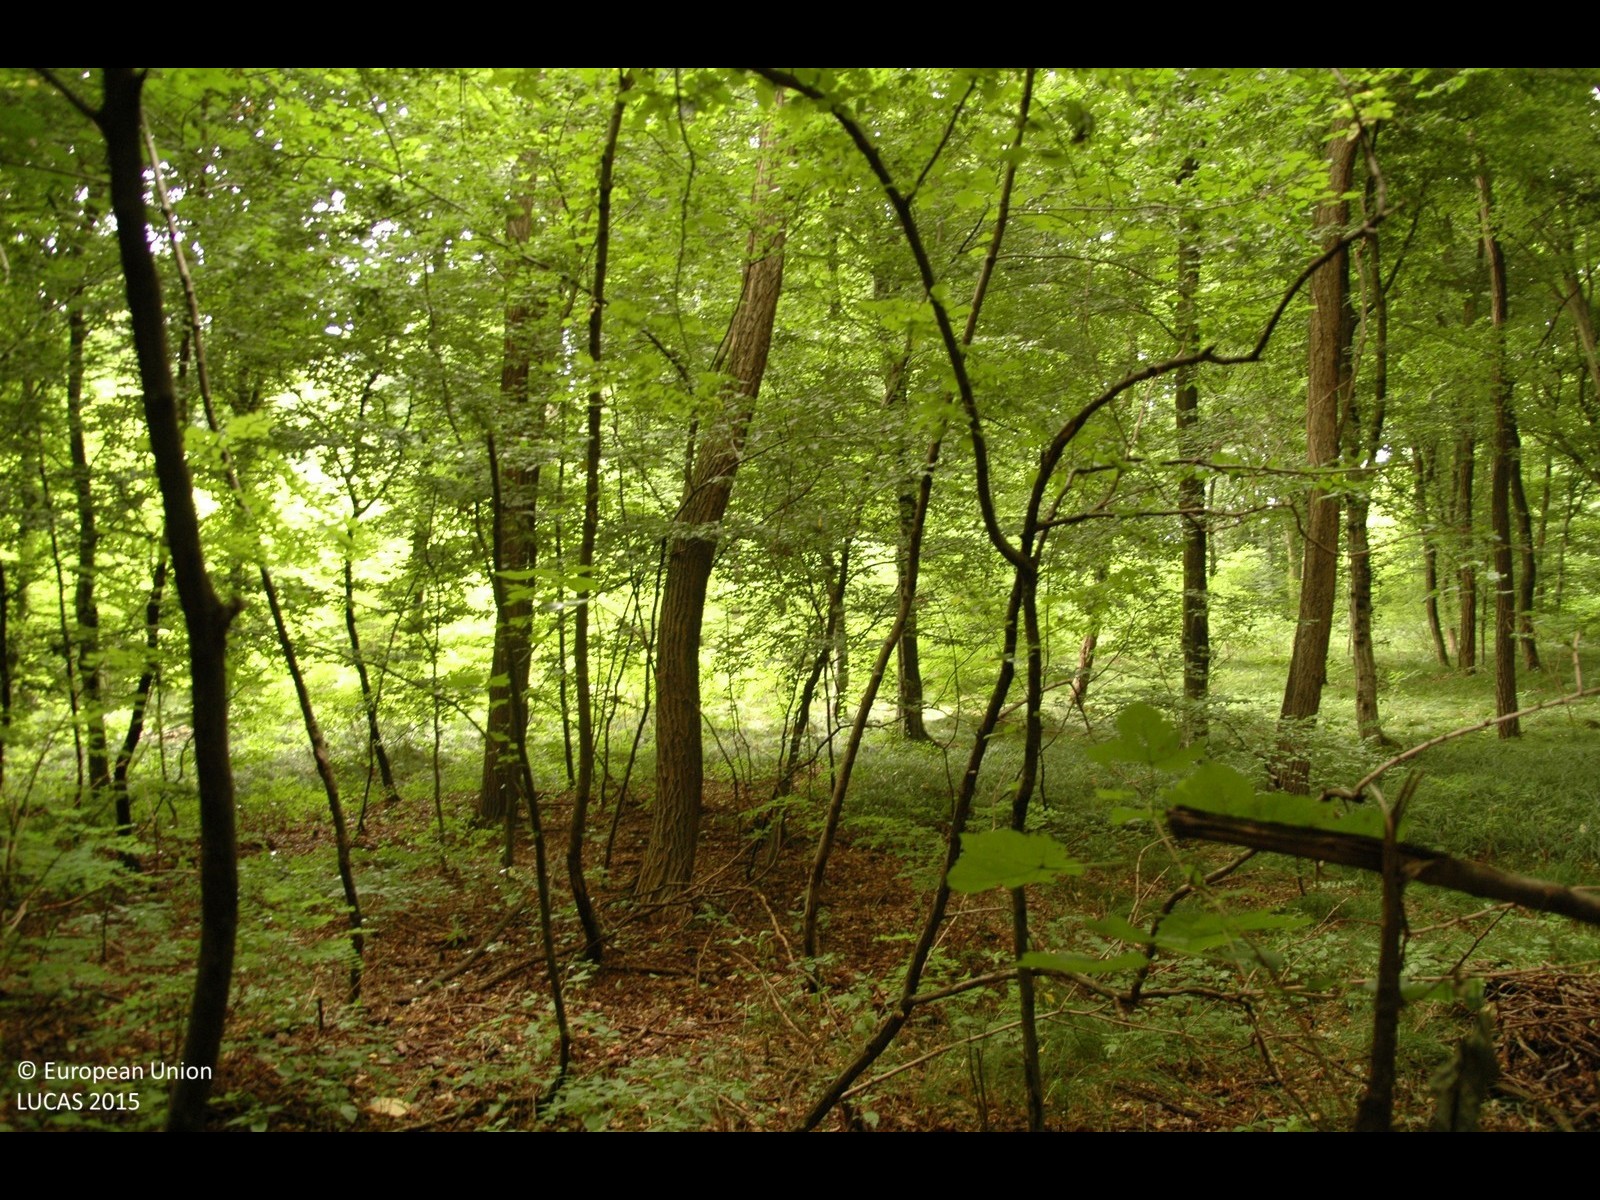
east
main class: Woodland
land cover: Broadleaved woodland
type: mesophytic deciduous forest
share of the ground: > 75 %
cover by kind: broadleaved forest trees 100 %
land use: Forestry
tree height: > 5 m
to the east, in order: Broadleaved woodland
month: July
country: HR
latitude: 46.4310
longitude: 16.3904
